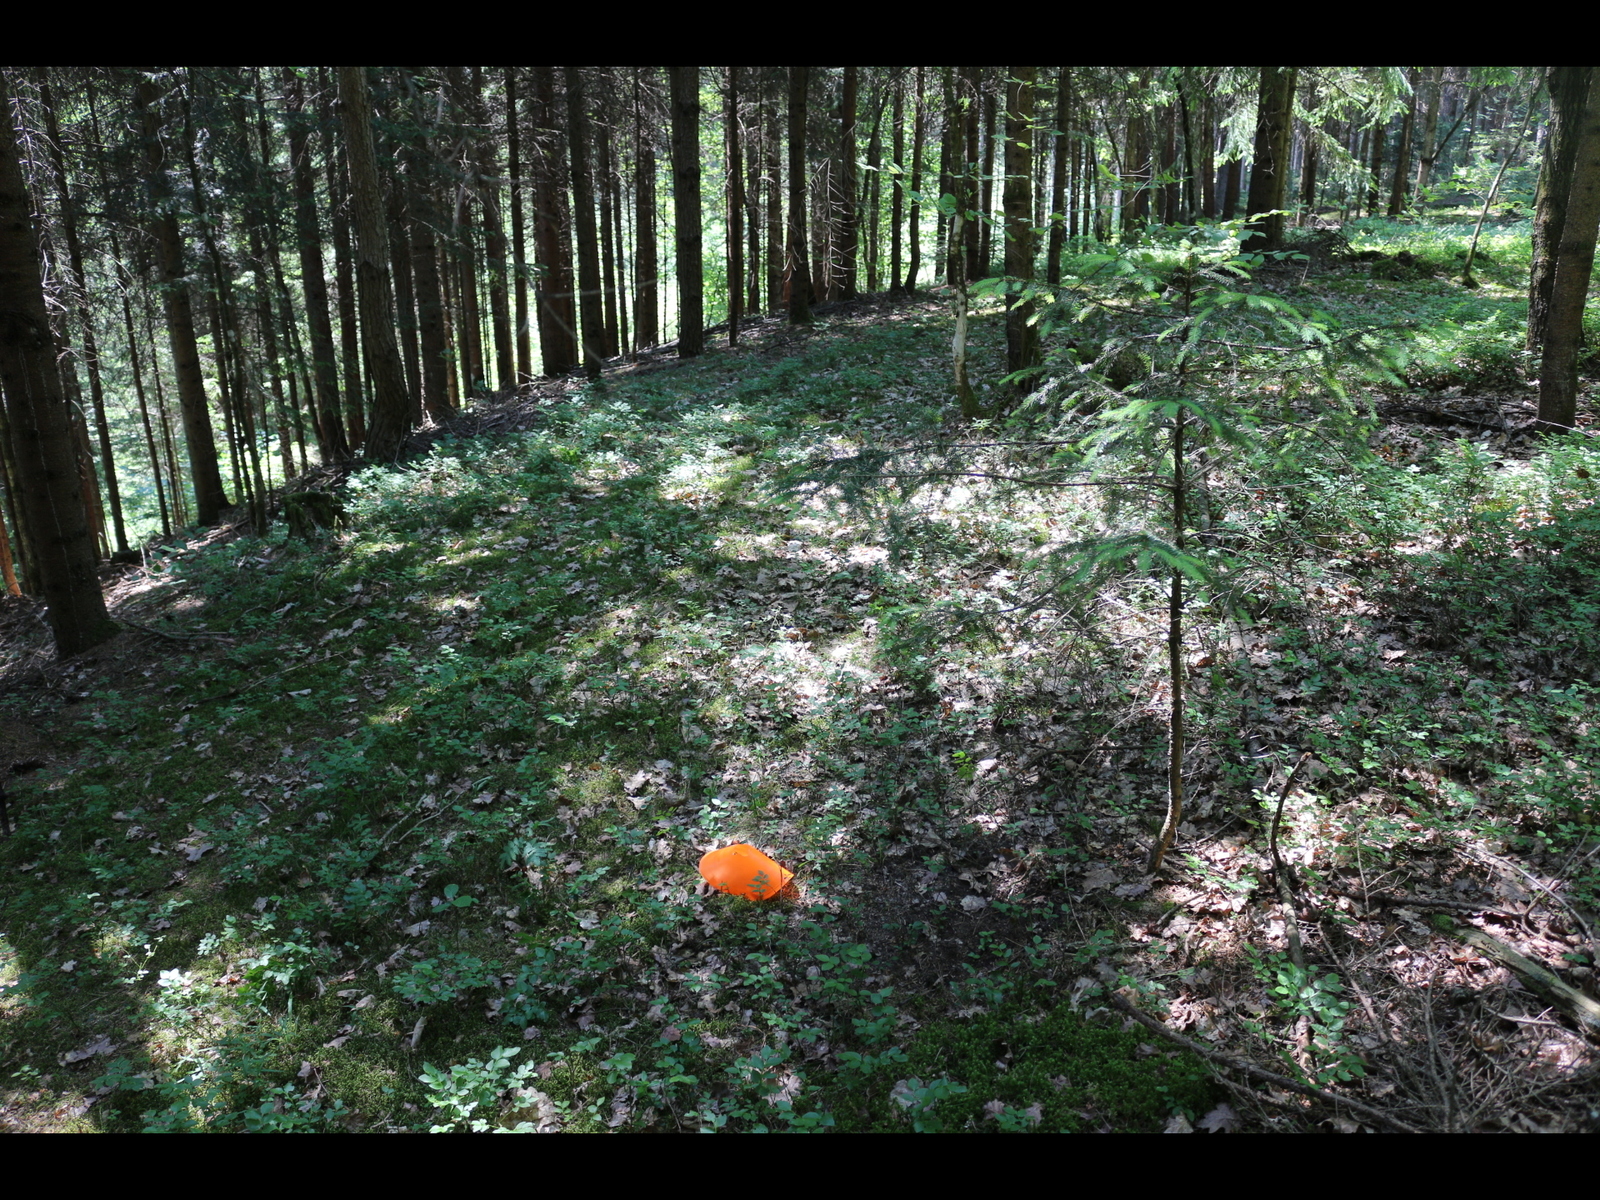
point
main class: Woodland
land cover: Spruce dominated coniferous woodland
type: alpine coniferous forest
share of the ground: > 75 %
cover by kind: coniferous forest trees 90 %, broadleaved forest trees 10 %
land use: Forestry
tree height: > 5 m
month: June
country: AT
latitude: 46.7047
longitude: 14.1175
